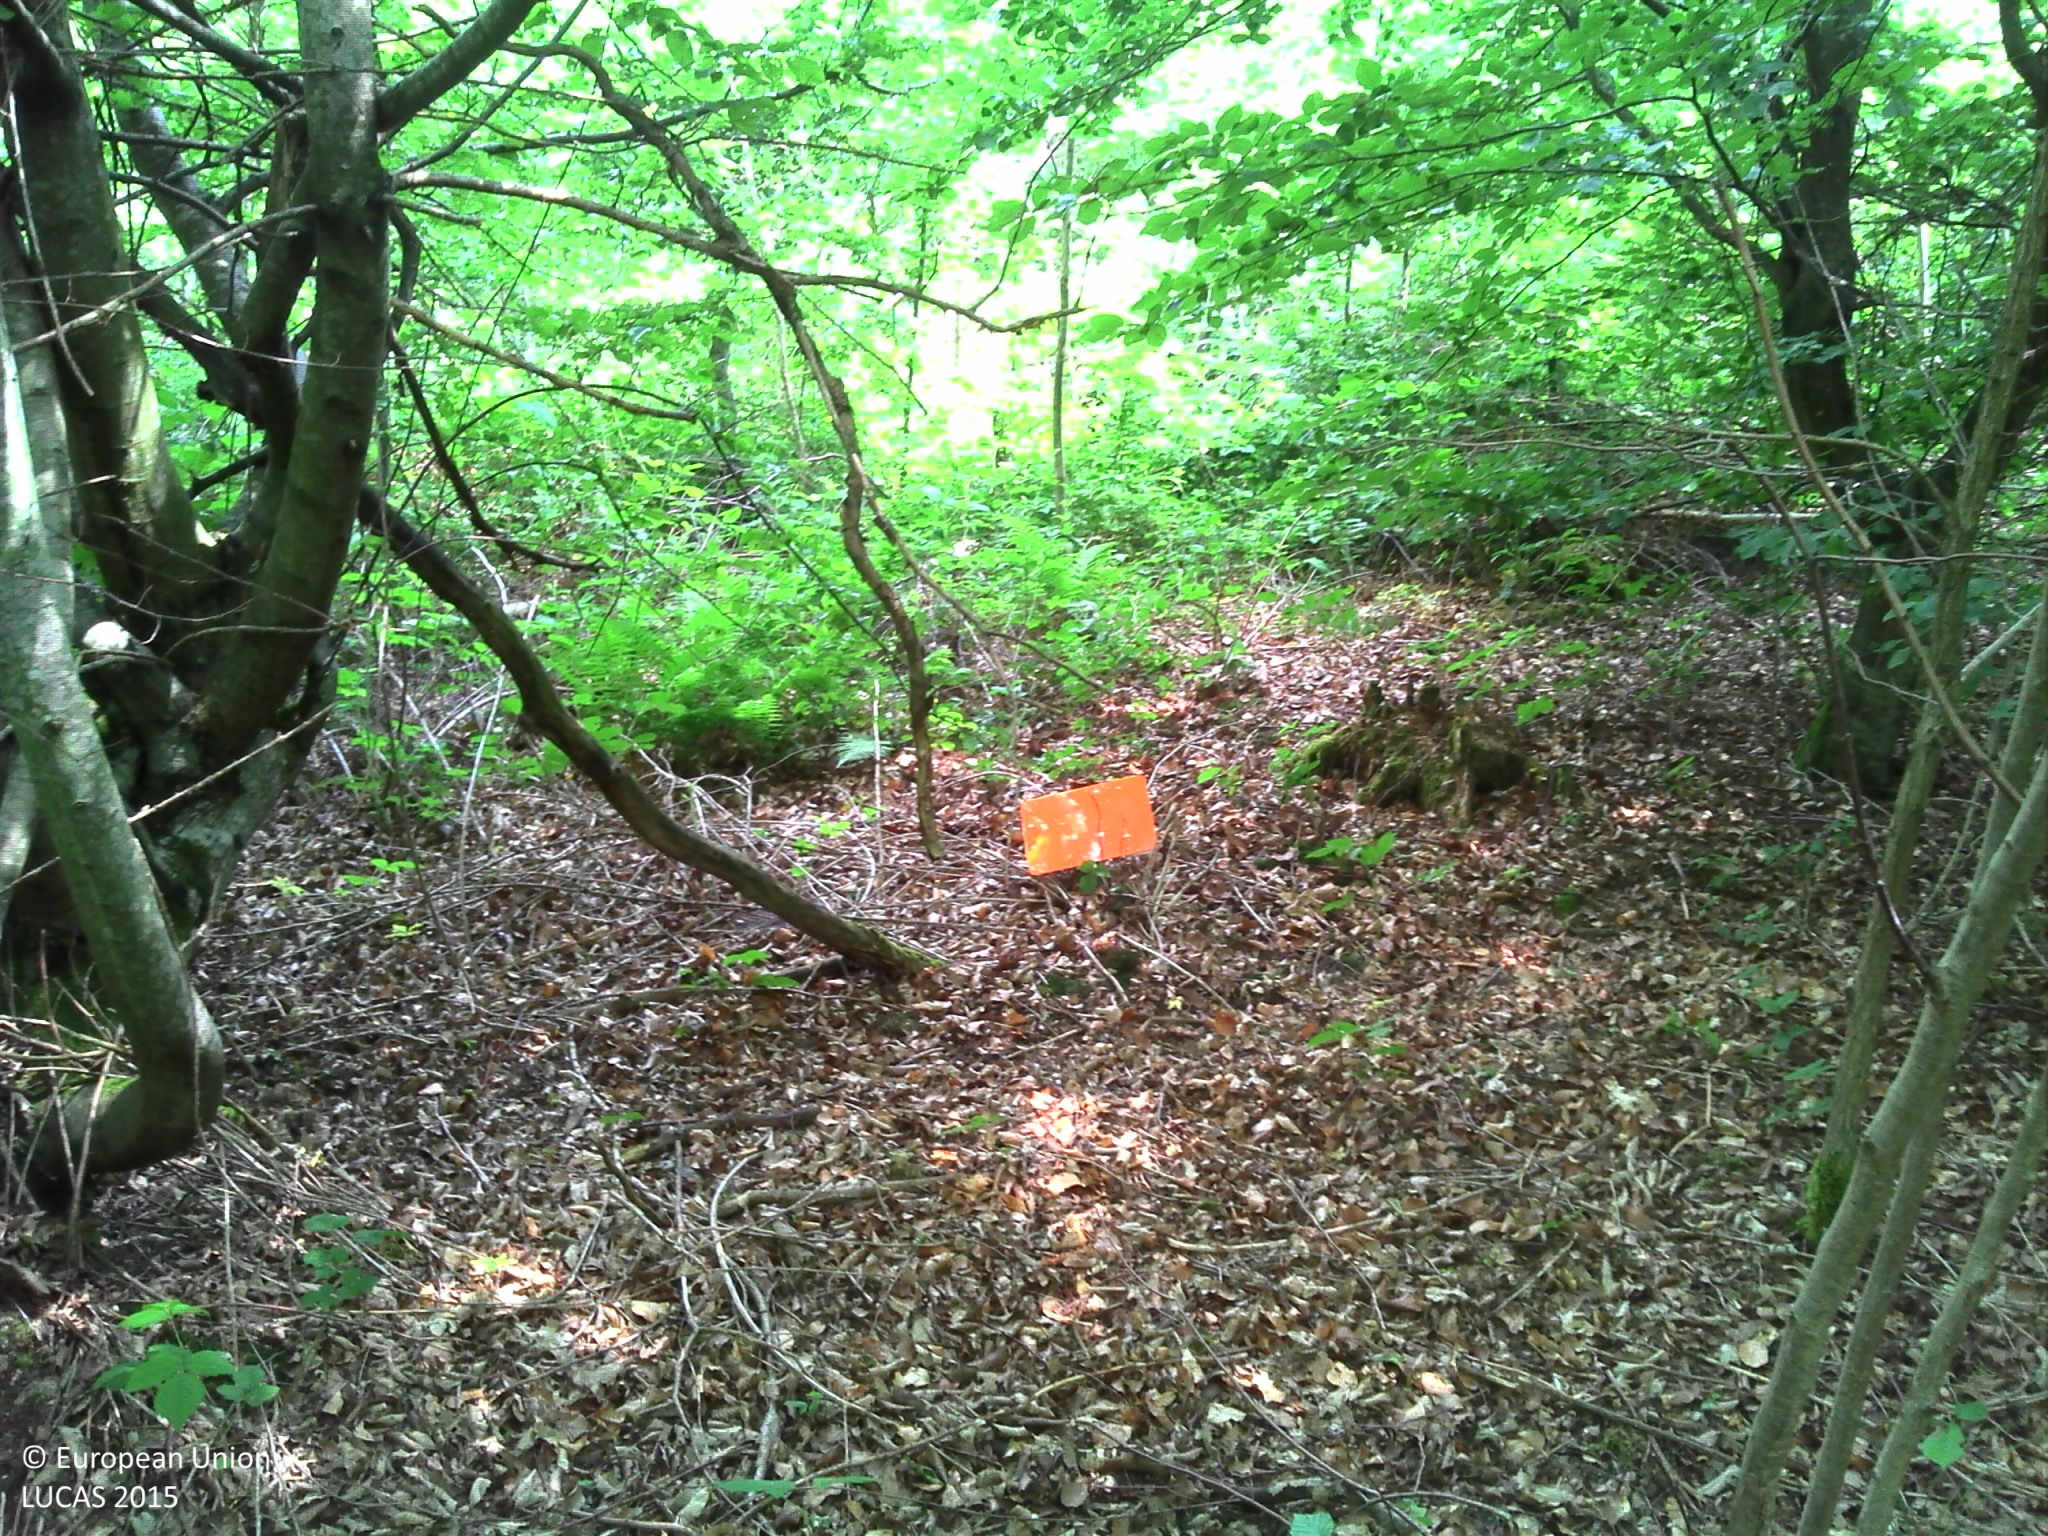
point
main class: Woodland
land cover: Broadleaved woodland
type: mesophytic deciduous forest
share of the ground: > 75 %
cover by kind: broadleaved forest trees 95 %, lichens and mosses 5 %
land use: Forestry
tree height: > 5 m
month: June
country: FR
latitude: 48.5371
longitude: 6.2215
